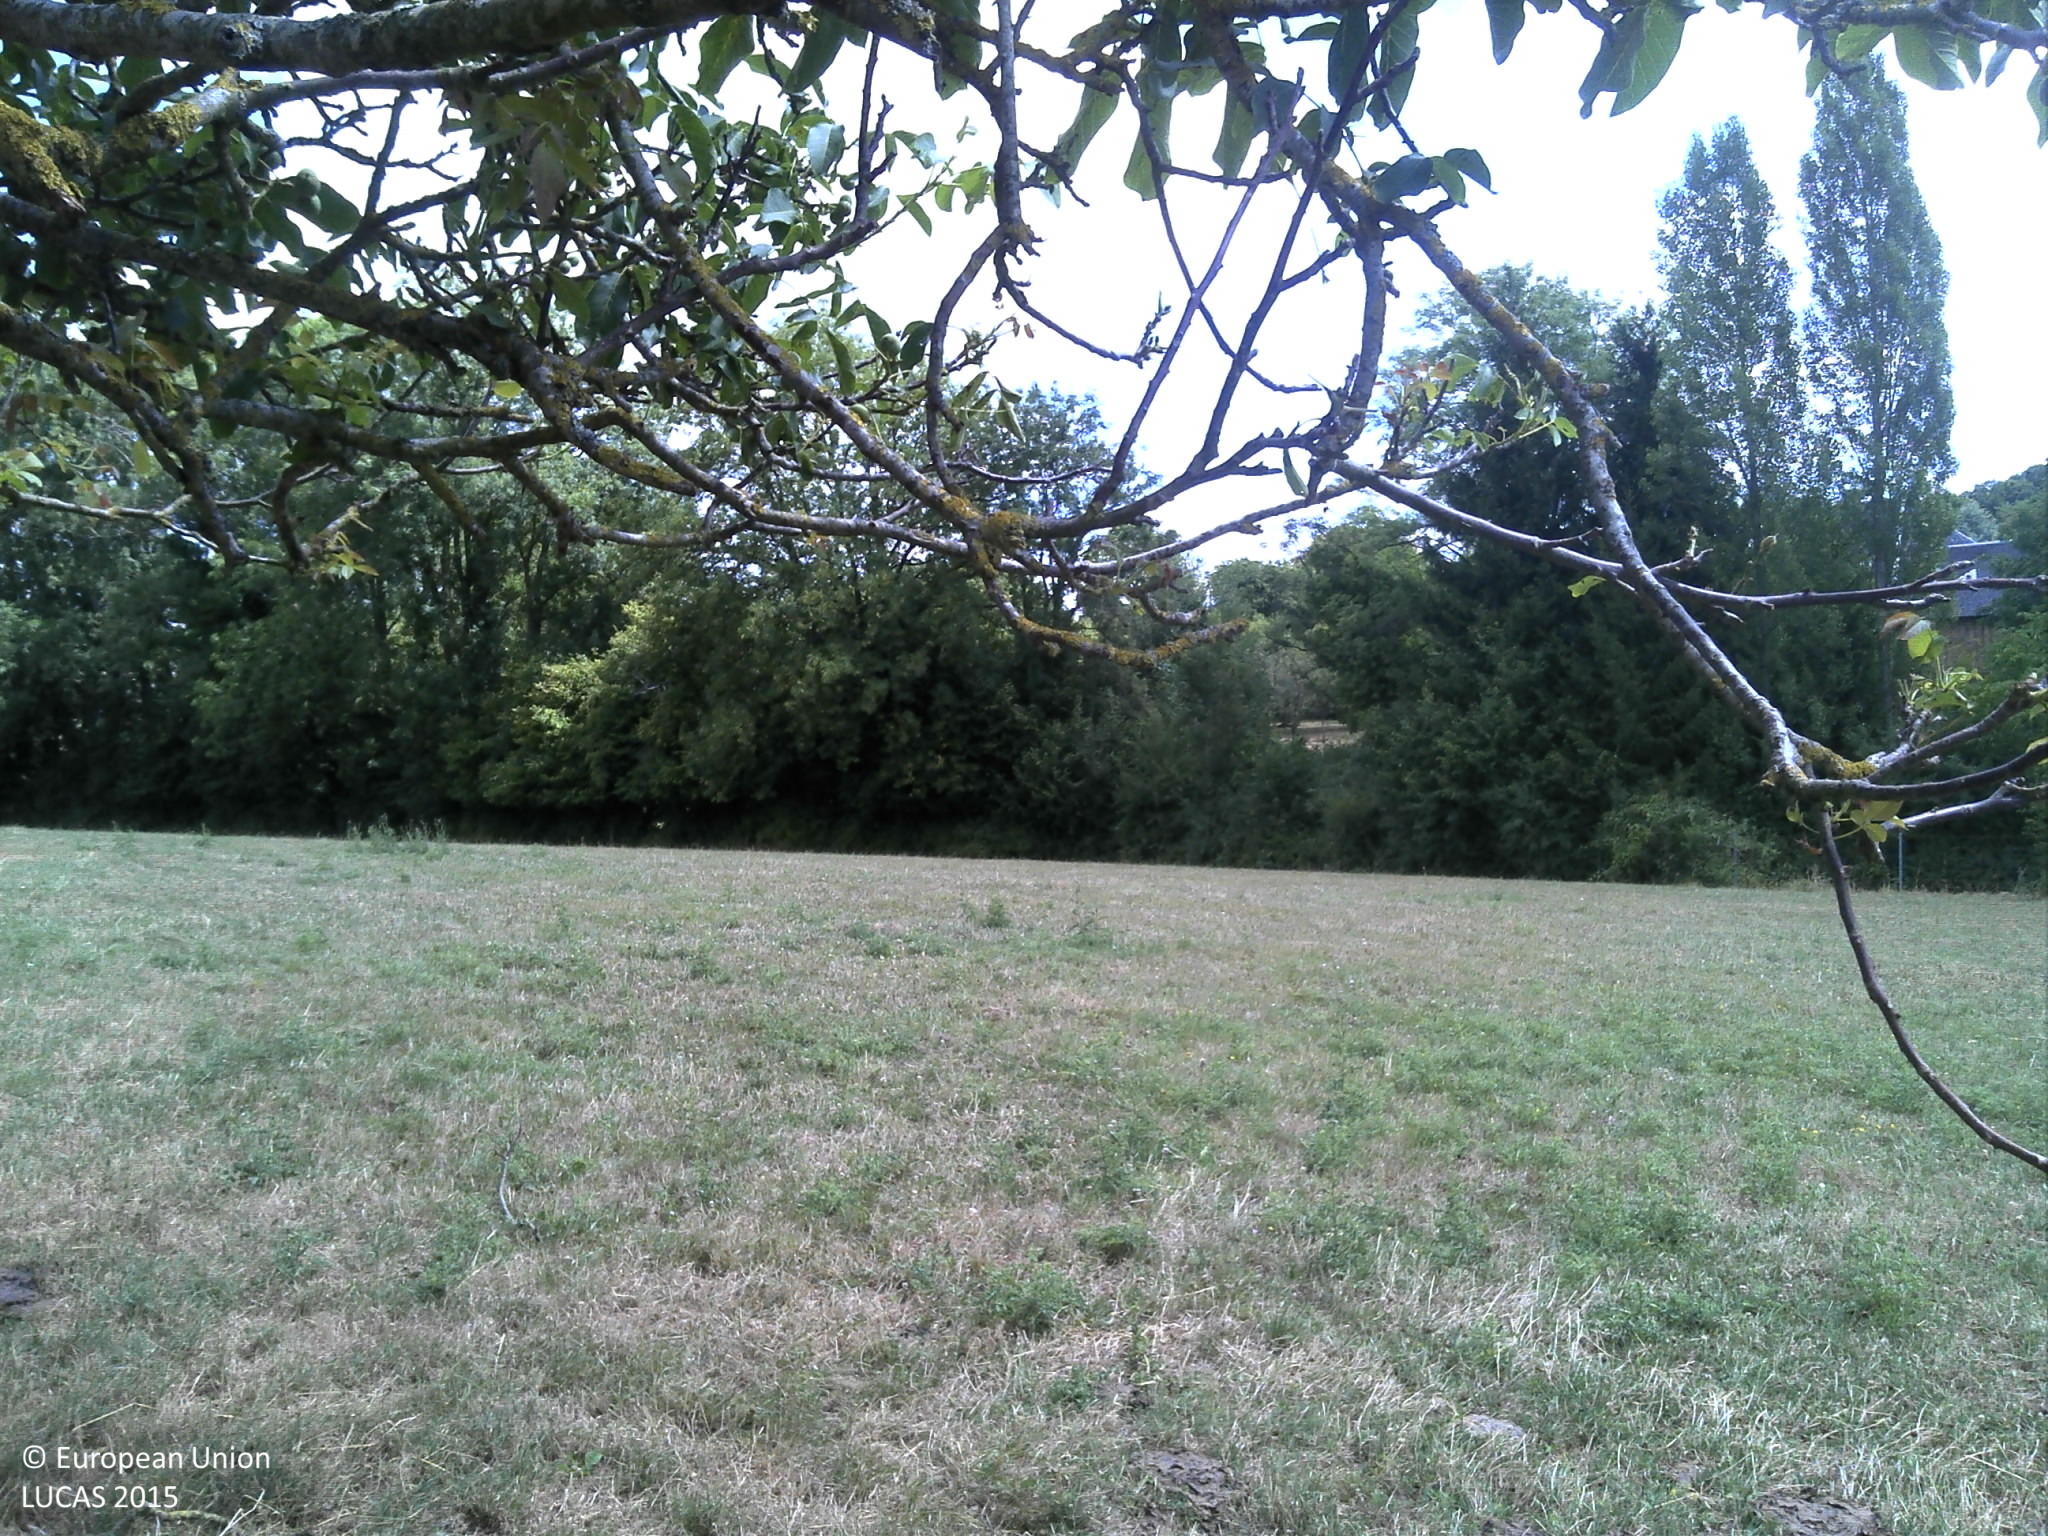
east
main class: Grassland
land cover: Grassland with sparse tree/shrub cover
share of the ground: > 75 %
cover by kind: herbaceous plants 95 %, broadleaved forest trees 5 %
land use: Agriculture (excluding fallow land and kitchen gardens)
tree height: > 5 m
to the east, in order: Grassland with sparse tree/shrub cover; Grassland without tree/shrub cover; Fences; Broadleaved woodland; Inland fresh water bodies; Broadleaved woodland; Grassland with sparse tree/shrub cover; Broadleaved woodland; Grass margins; Paved roads, cycling and walking lanes; Grassland without tree/shrub cover; Fences; Grassland with sparse tree/shrub cover; Broadleaved woodland
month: July
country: FR
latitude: 49.6176
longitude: 4.4734
